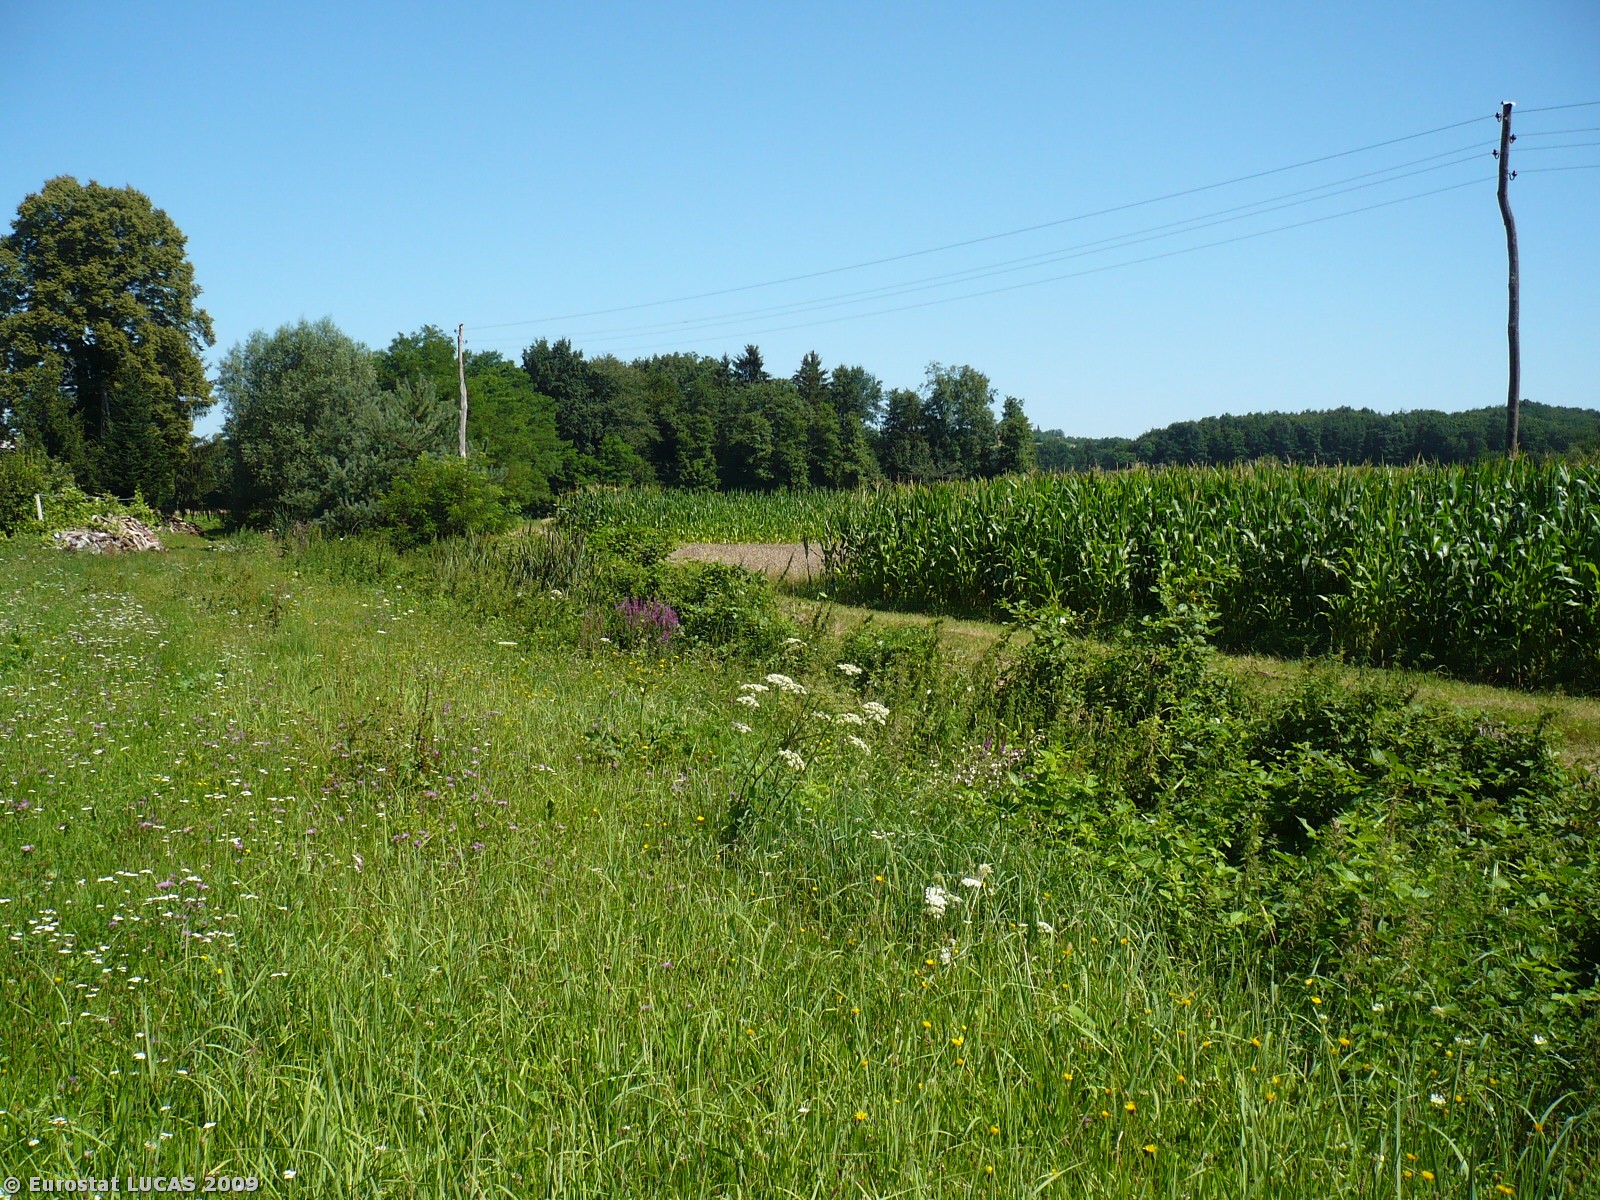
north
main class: Grassland
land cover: Grassland without tree/shrub cover
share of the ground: > 75 %
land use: Agriculture (excluding fallow land and kitchen gardens)
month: July
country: SI
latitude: 46.7392
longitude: 16.0601
